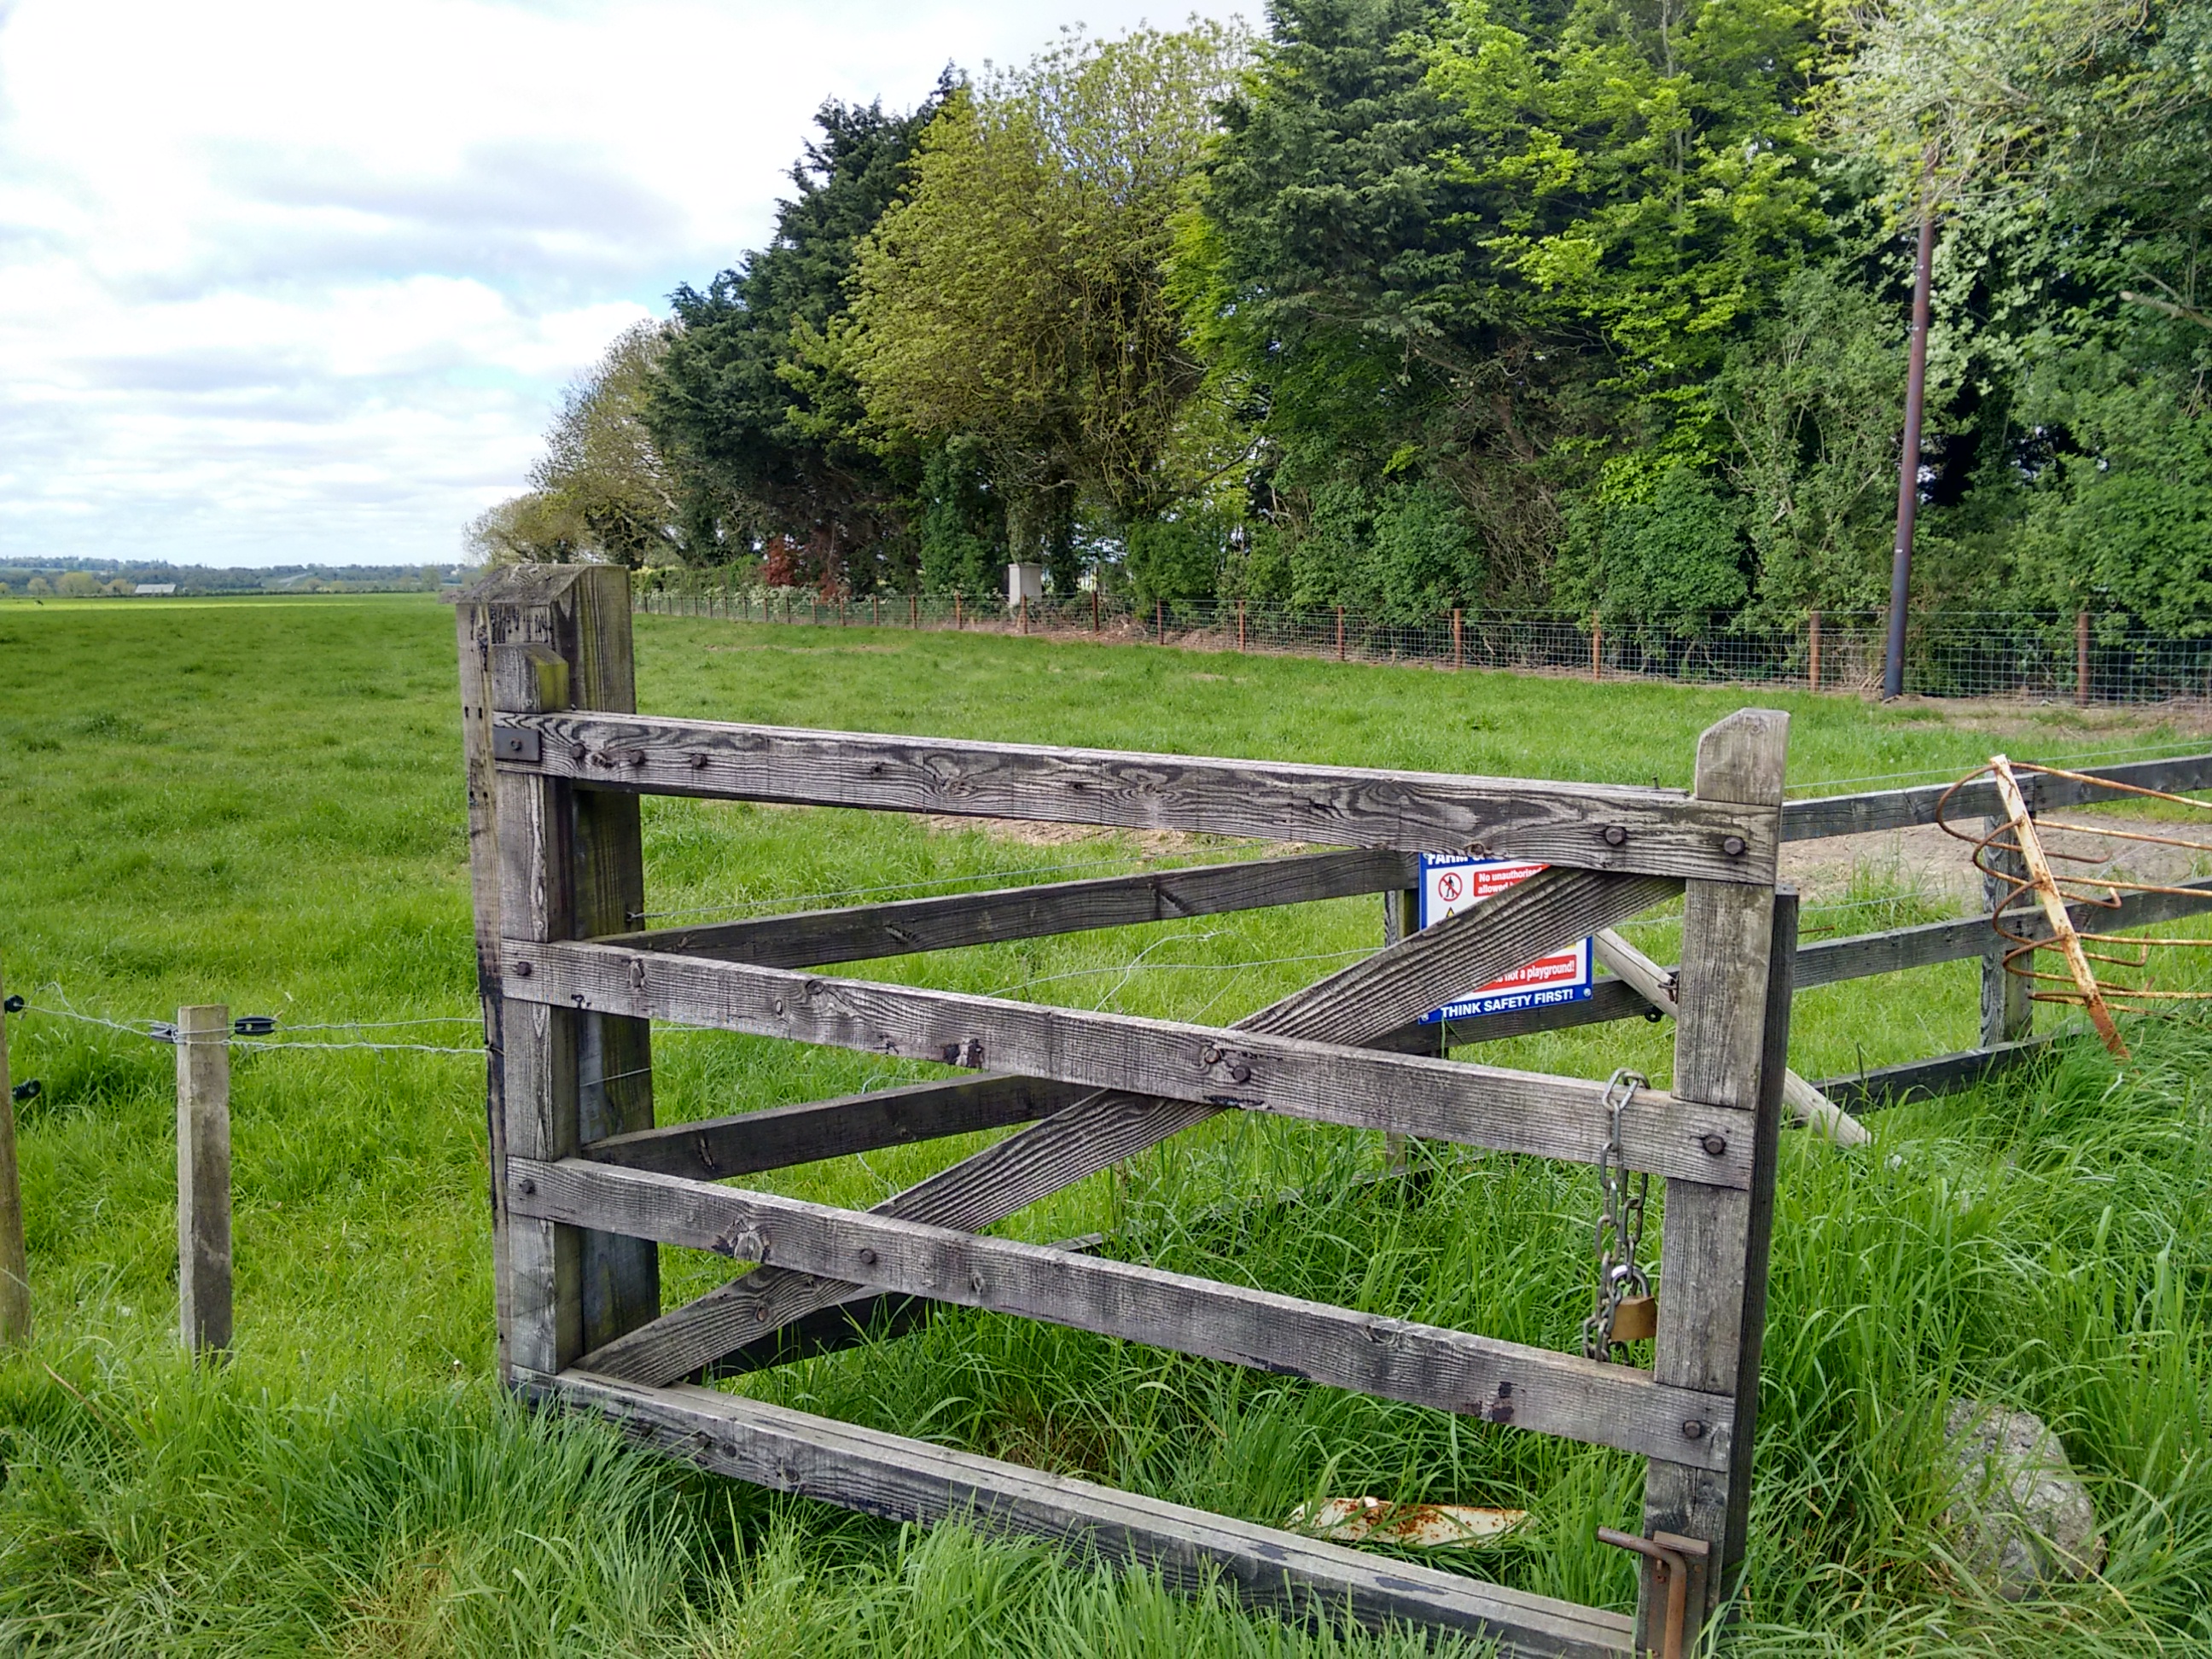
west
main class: Grassland
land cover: Grassland without tree/shrub cover
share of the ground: > 75 %
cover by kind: herbaceous plants 100 %
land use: Agriculture (excluding fallow land and kitchen gardens)
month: May
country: IE
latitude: 53.5019
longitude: -6.5459
